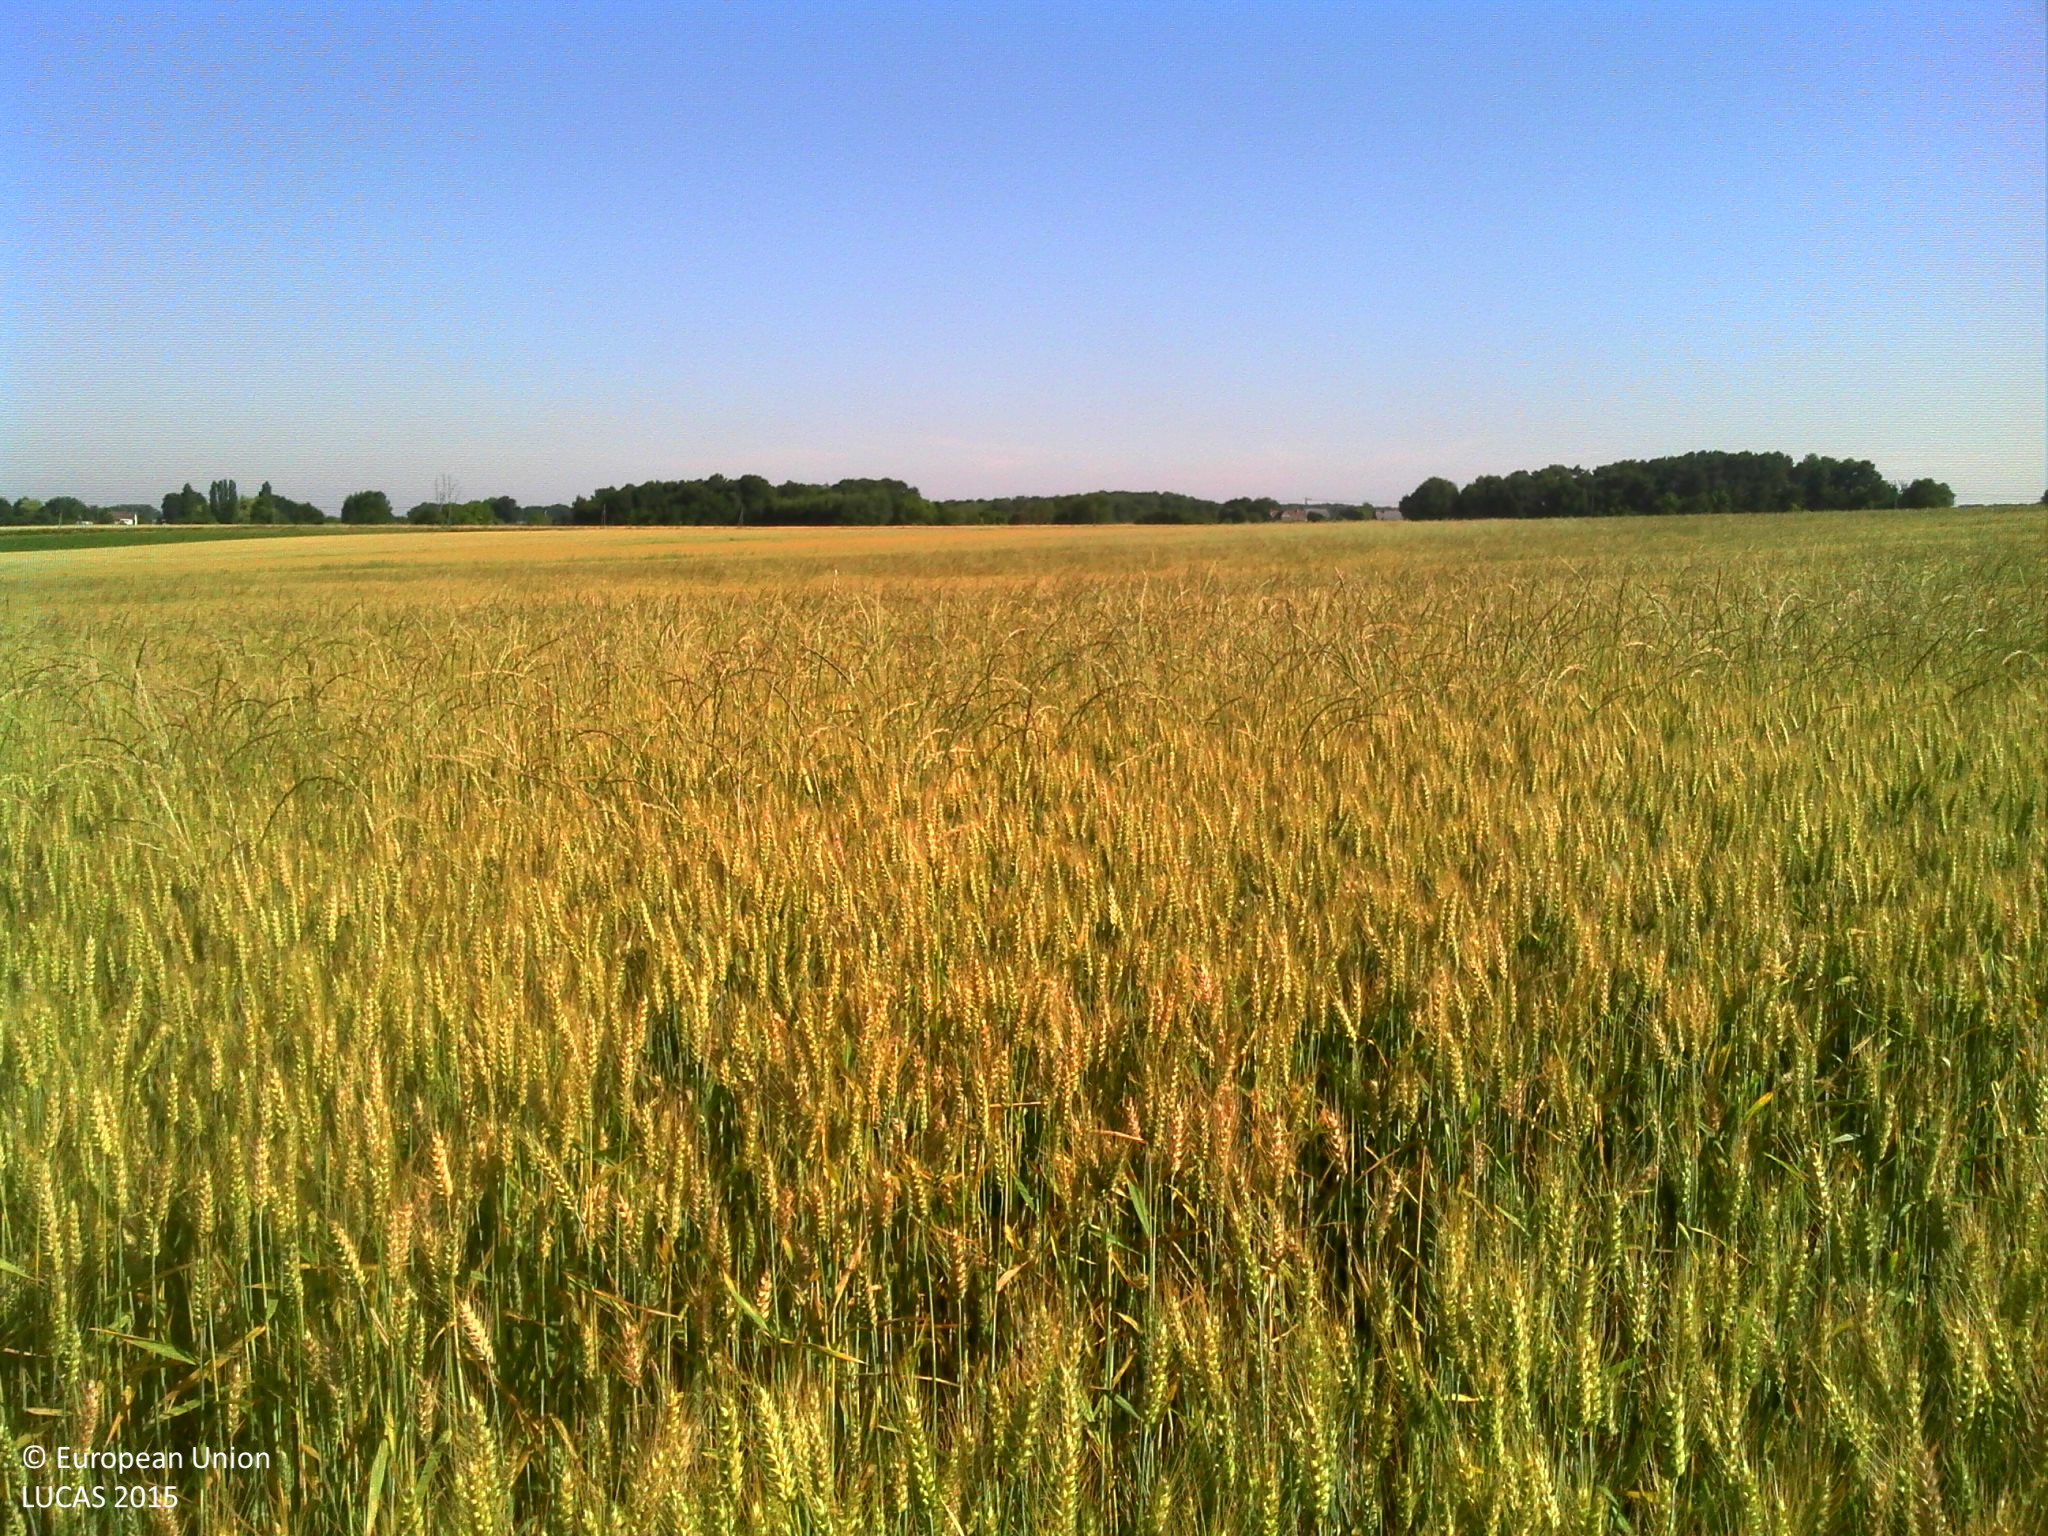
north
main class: Cropland
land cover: Durum wheat
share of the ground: > 75 %
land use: Agriculture (excluding fallow land and kitchen gardens)
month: June
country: FR
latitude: 47.5032
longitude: 0.4861
